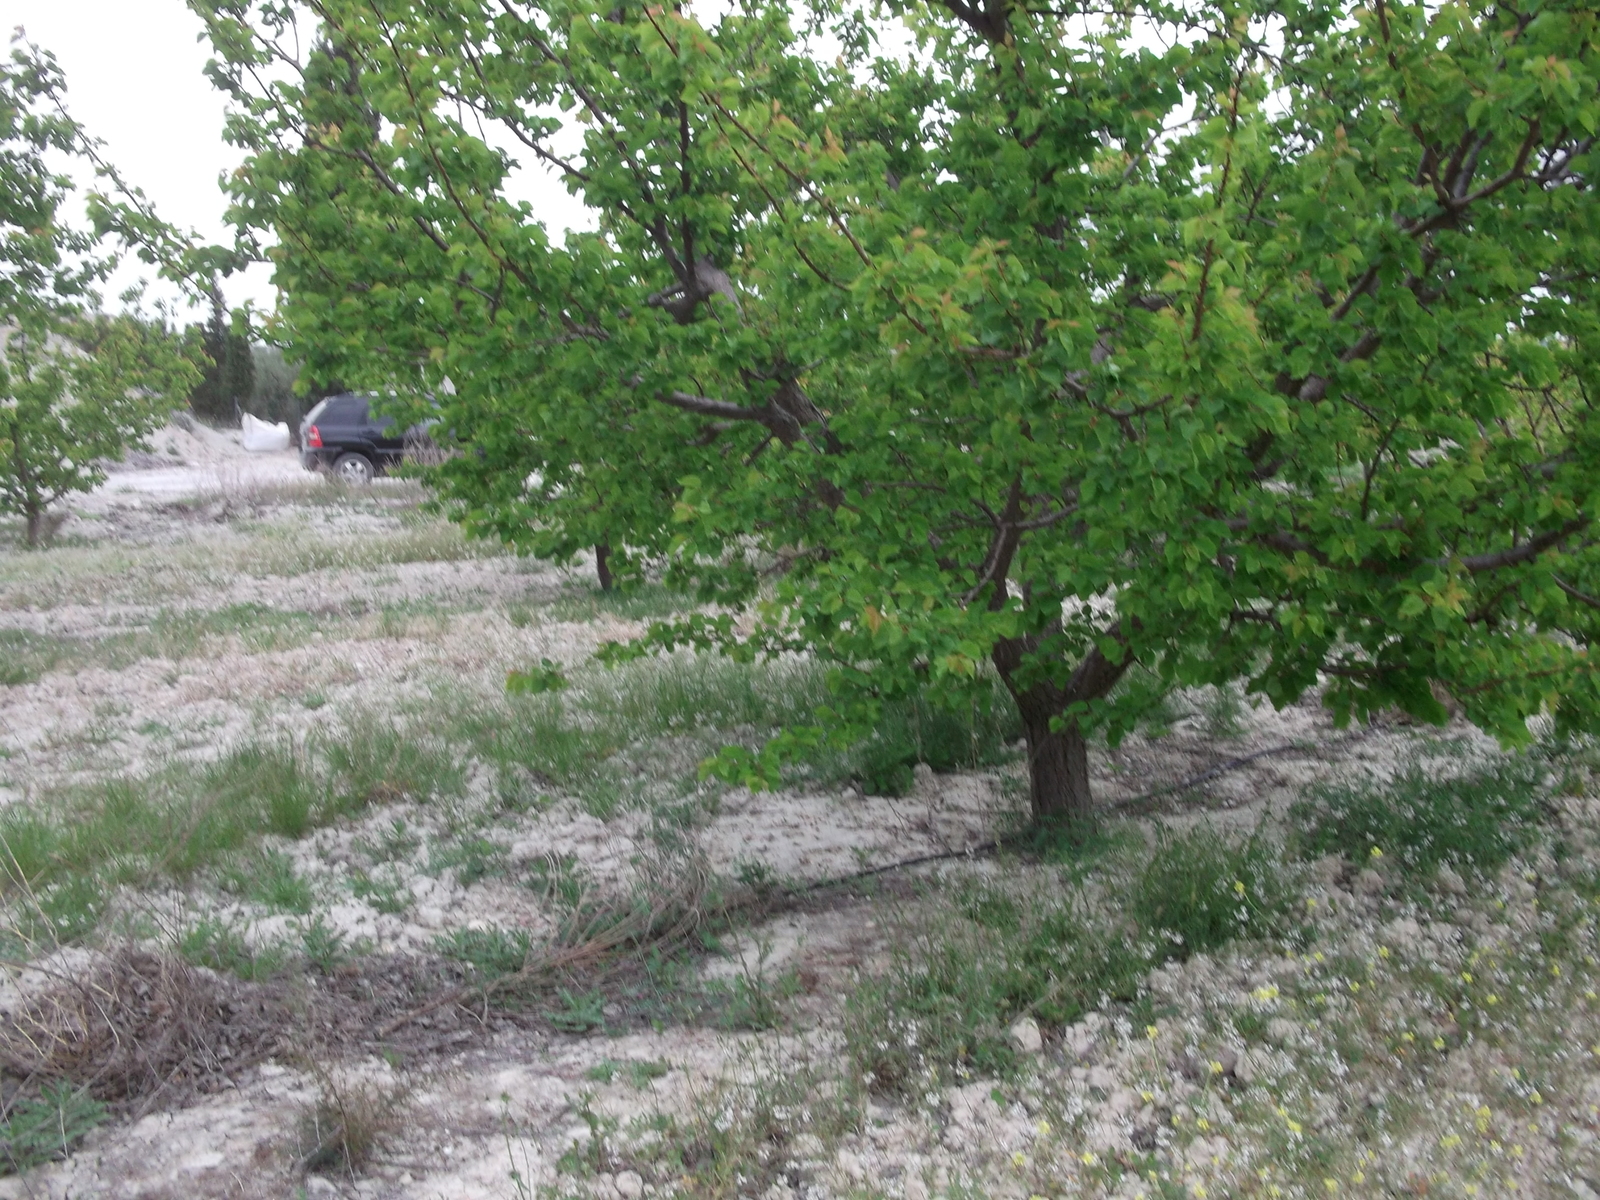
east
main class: Cropland
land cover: Other fruit trees and berries
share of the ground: 10 - 25 %
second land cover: Spontaneously vegetated surfaces
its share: > 75 %
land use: Agriculture (excluding fallow land and kitchen gardens)
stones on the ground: < 10 %
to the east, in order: Other fruit trees and berries; Spontaneously vegetated surfaces; Tracks; Fences; Artificial constructions in urban areas; Olive groves; Other fruit trees and berries; Grass margins; Other fruit trees and berries
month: April
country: ES
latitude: 38.0609
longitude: -1.4407
